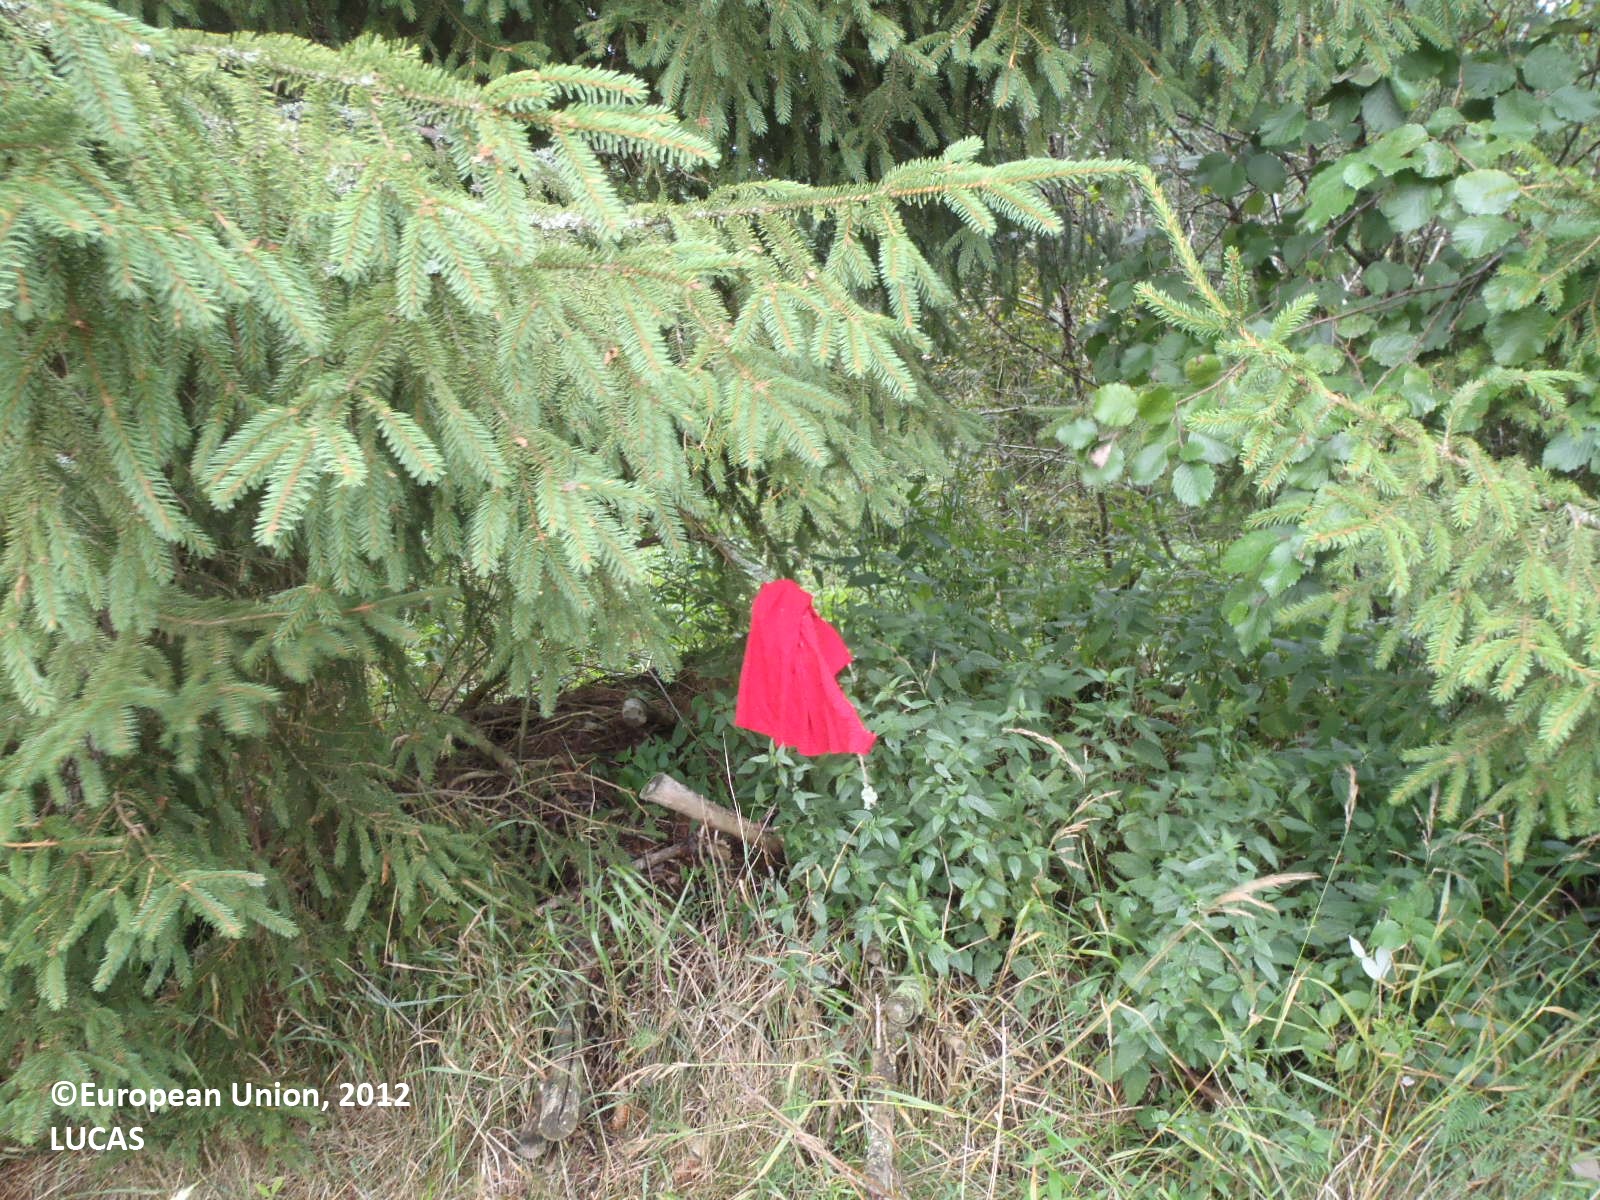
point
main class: Woodland
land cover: Spruce dominated mixed woodland
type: boreal forest
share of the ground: > 75 %
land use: Forestry
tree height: > 5 m
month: August
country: FI
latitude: 60.6886
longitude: 22.2056
